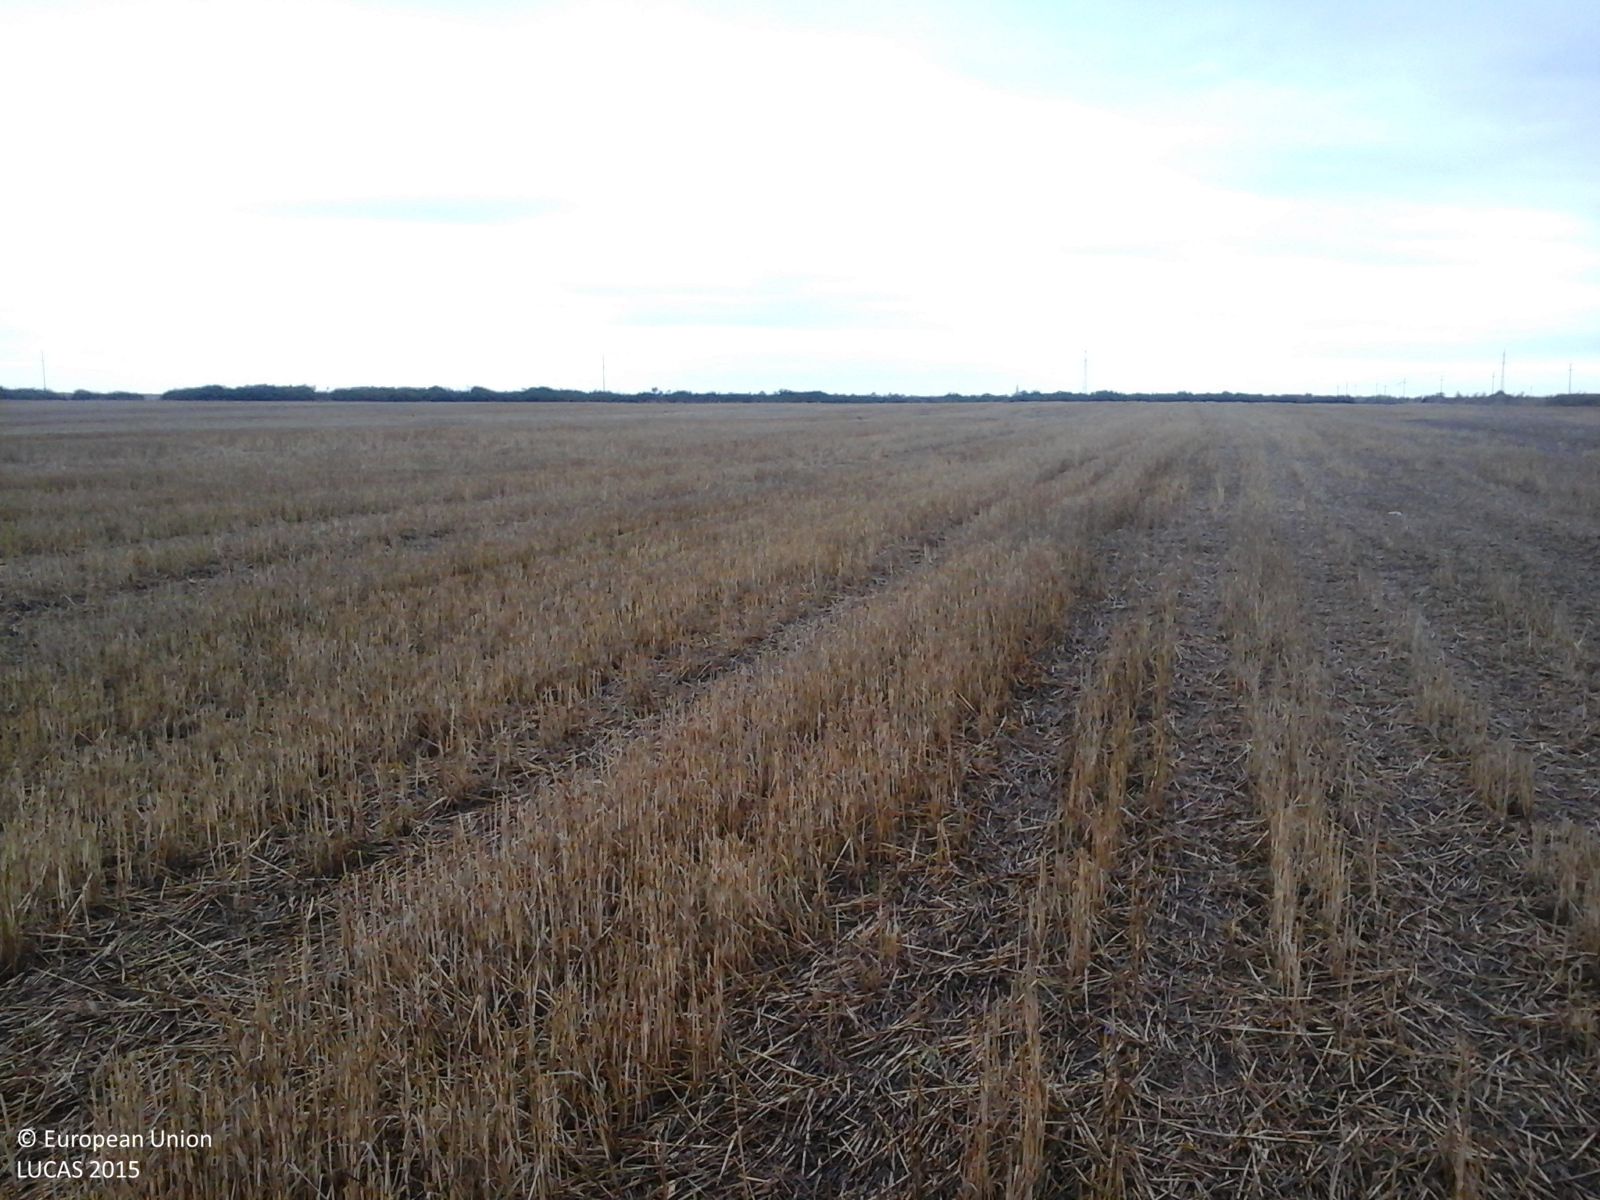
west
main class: Cropland
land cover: Common wheat
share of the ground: 50 - 75 %
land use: Agriculture (excluding fallow land and kitchen gardens)
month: August
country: RO
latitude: 45.5659
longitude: 20.9816
